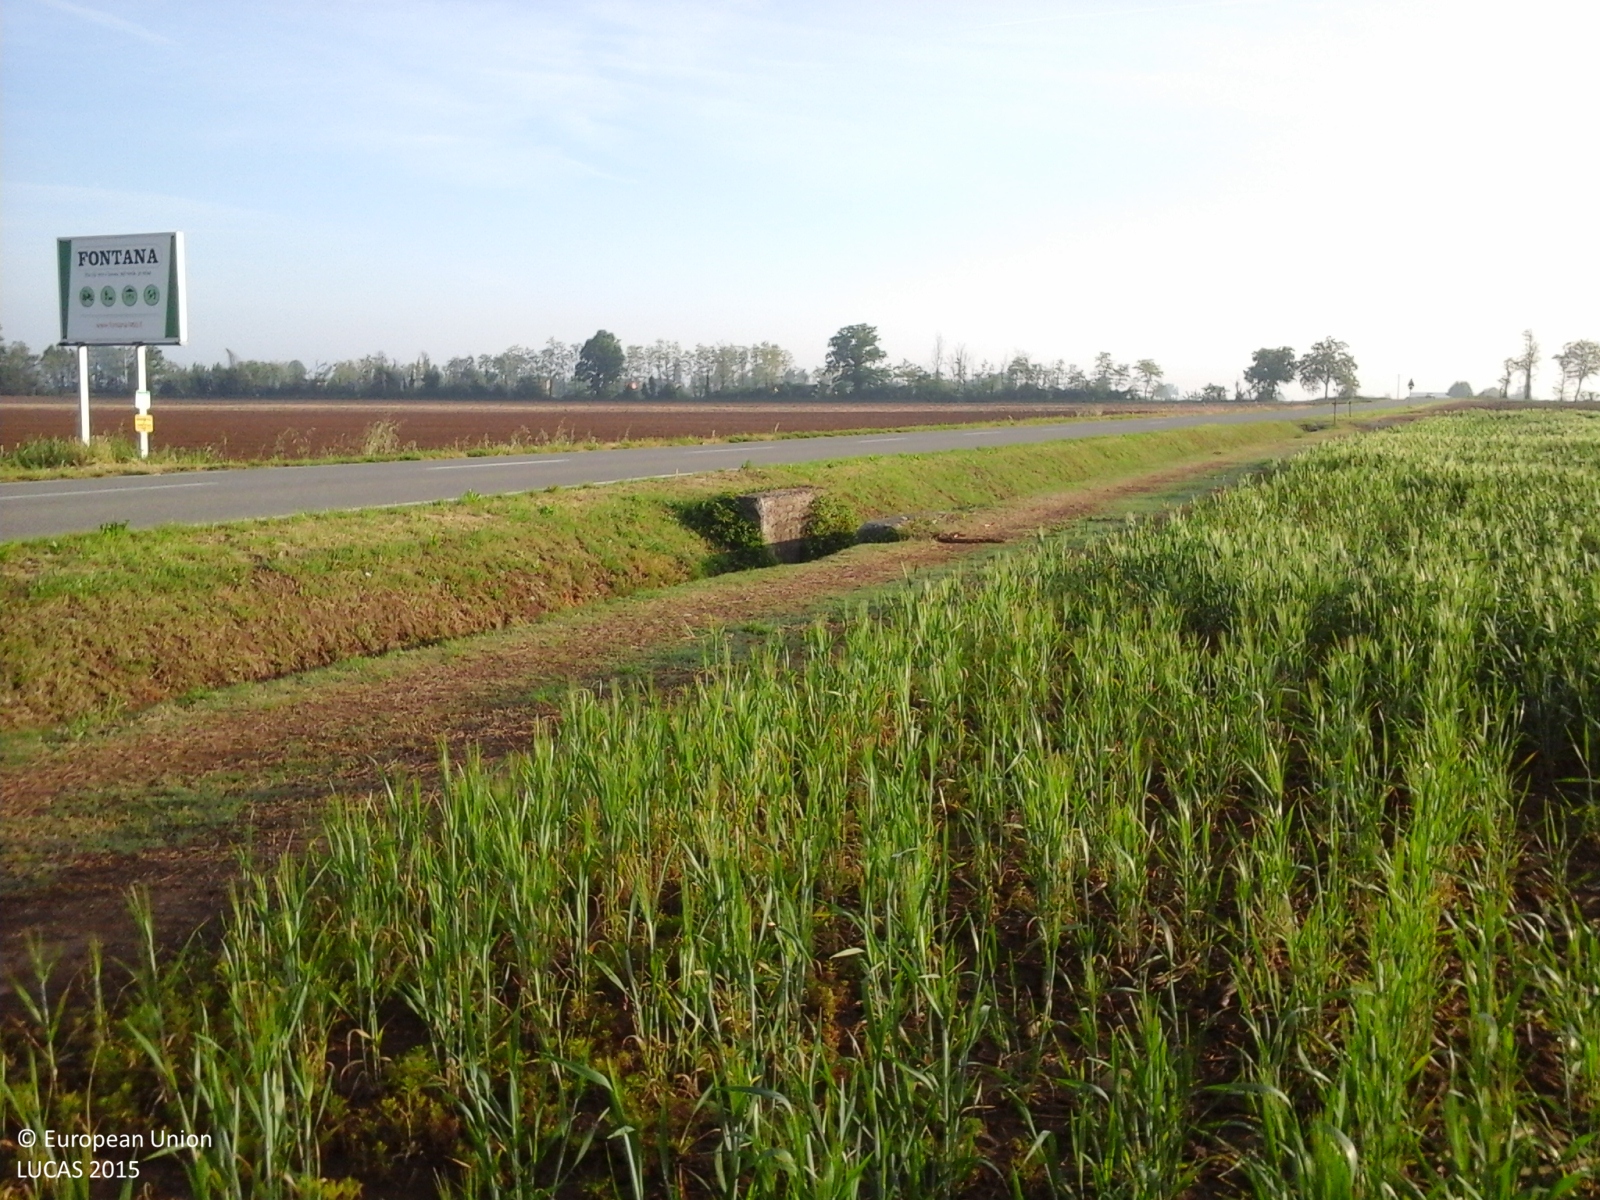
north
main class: Cropland
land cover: Common wheat
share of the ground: > 75 %
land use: Agriculture (excluding fallow land and kitchen gardens)
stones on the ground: < 10 %
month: May
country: IT
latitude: 44.9269
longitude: 9.6080
